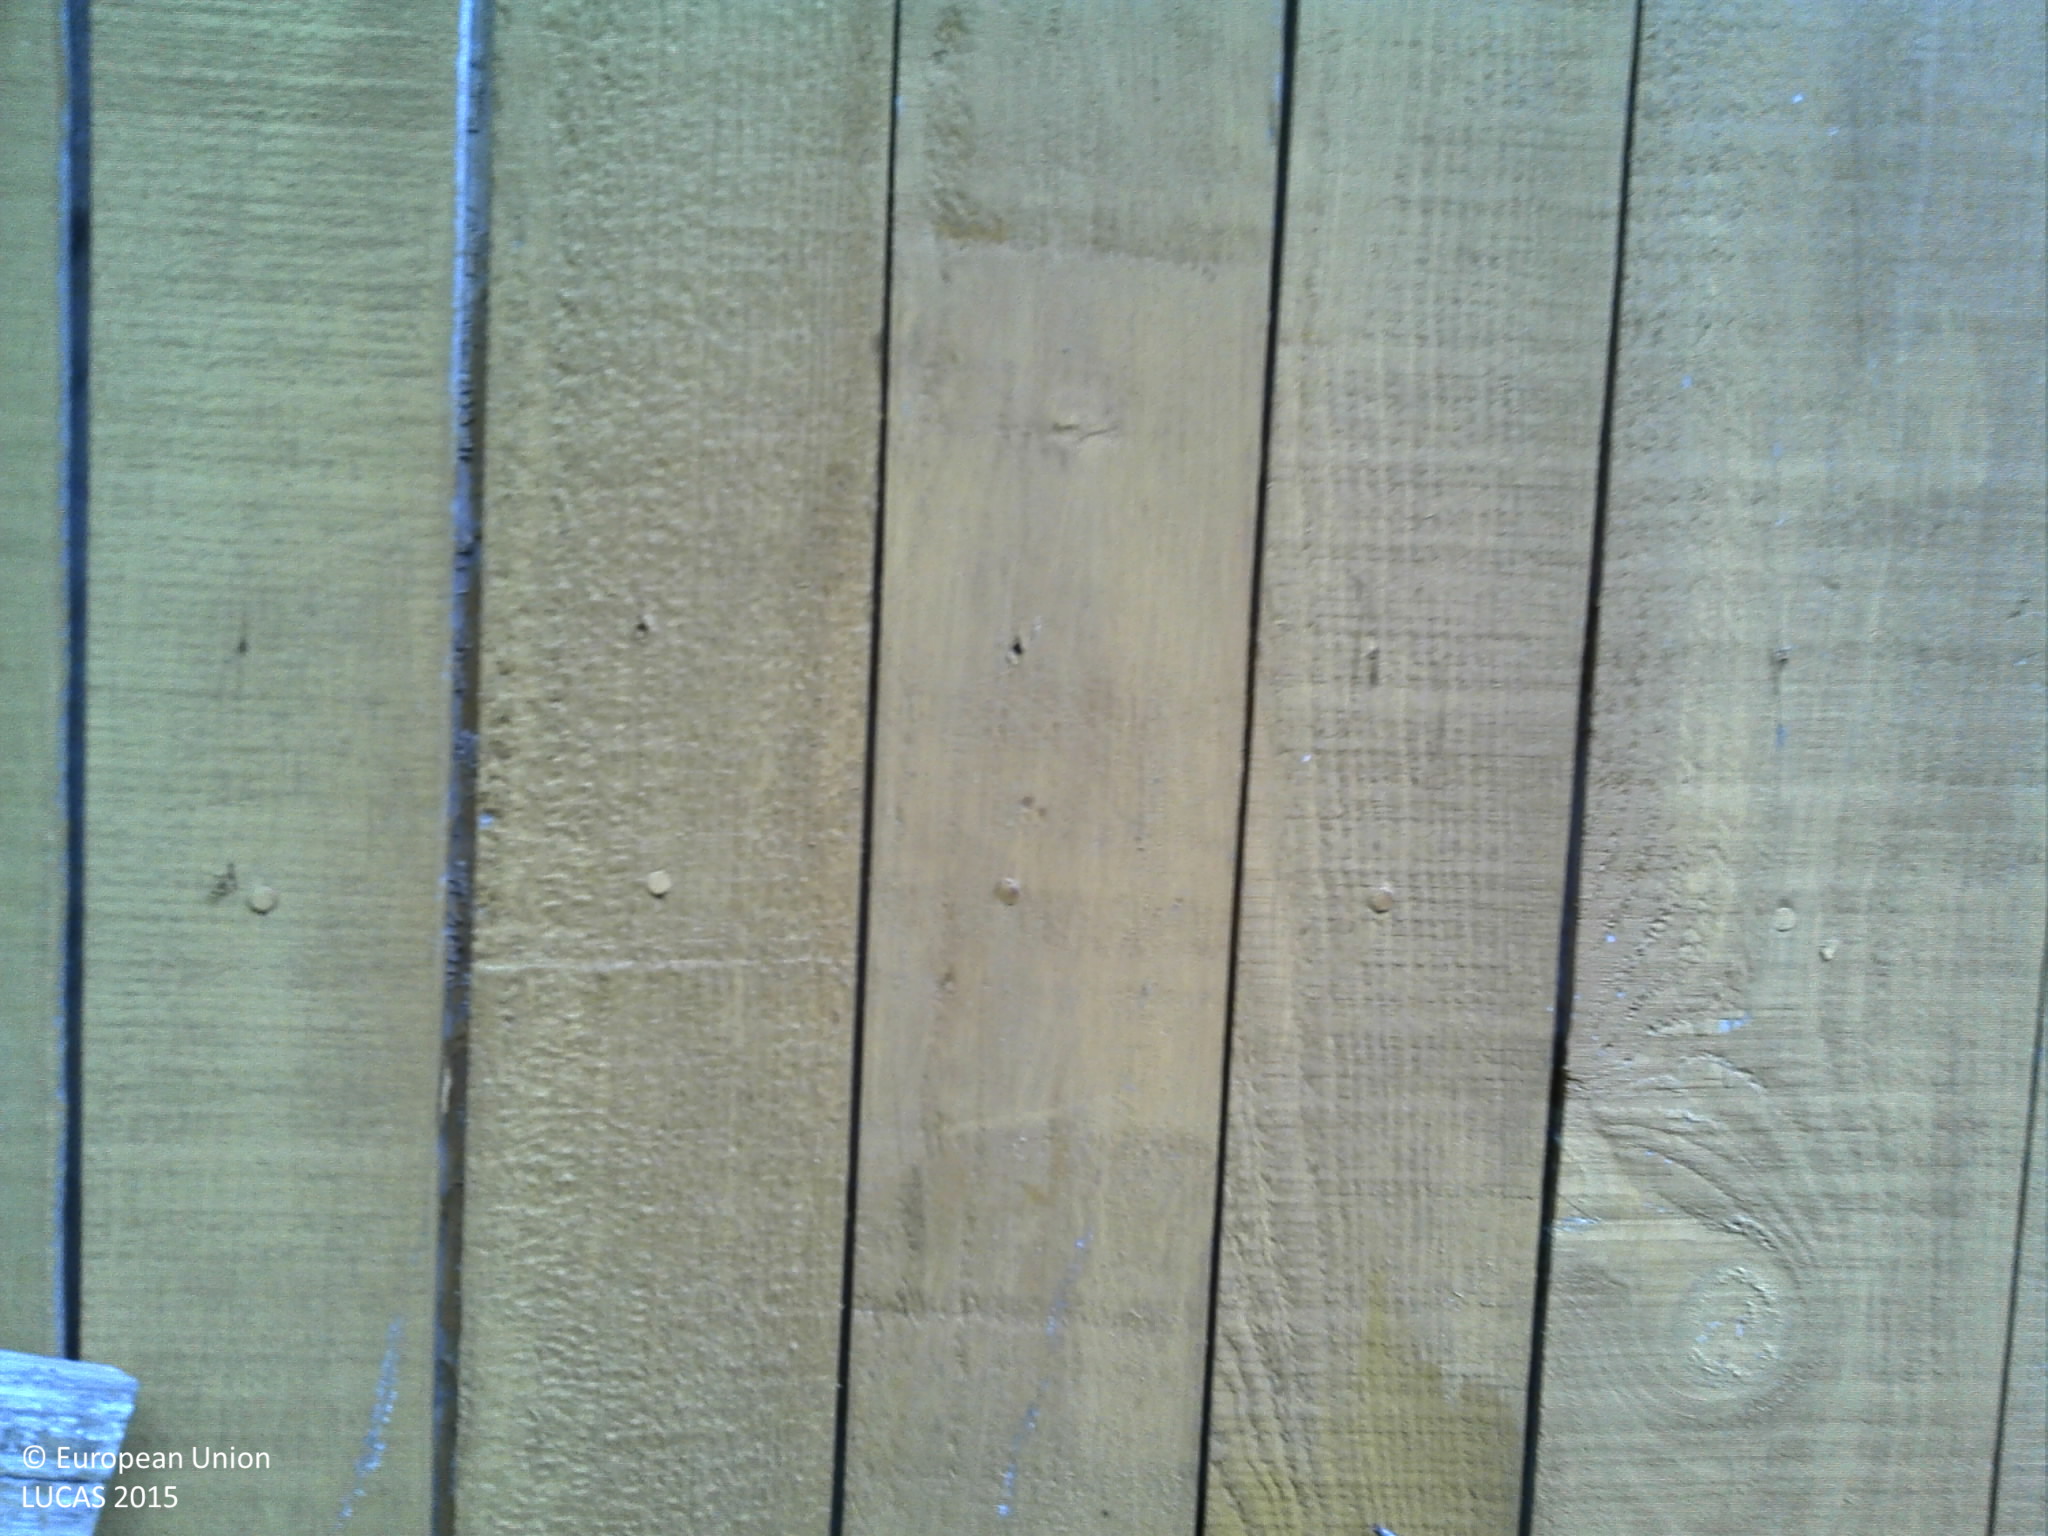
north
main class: Grassland
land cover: Grassland without tree/shrub cover
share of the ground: > 75 %
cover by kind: herbaceous plants 100 %
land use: Residential
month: June
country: FR
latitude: 47.9399
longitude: -3.6127
